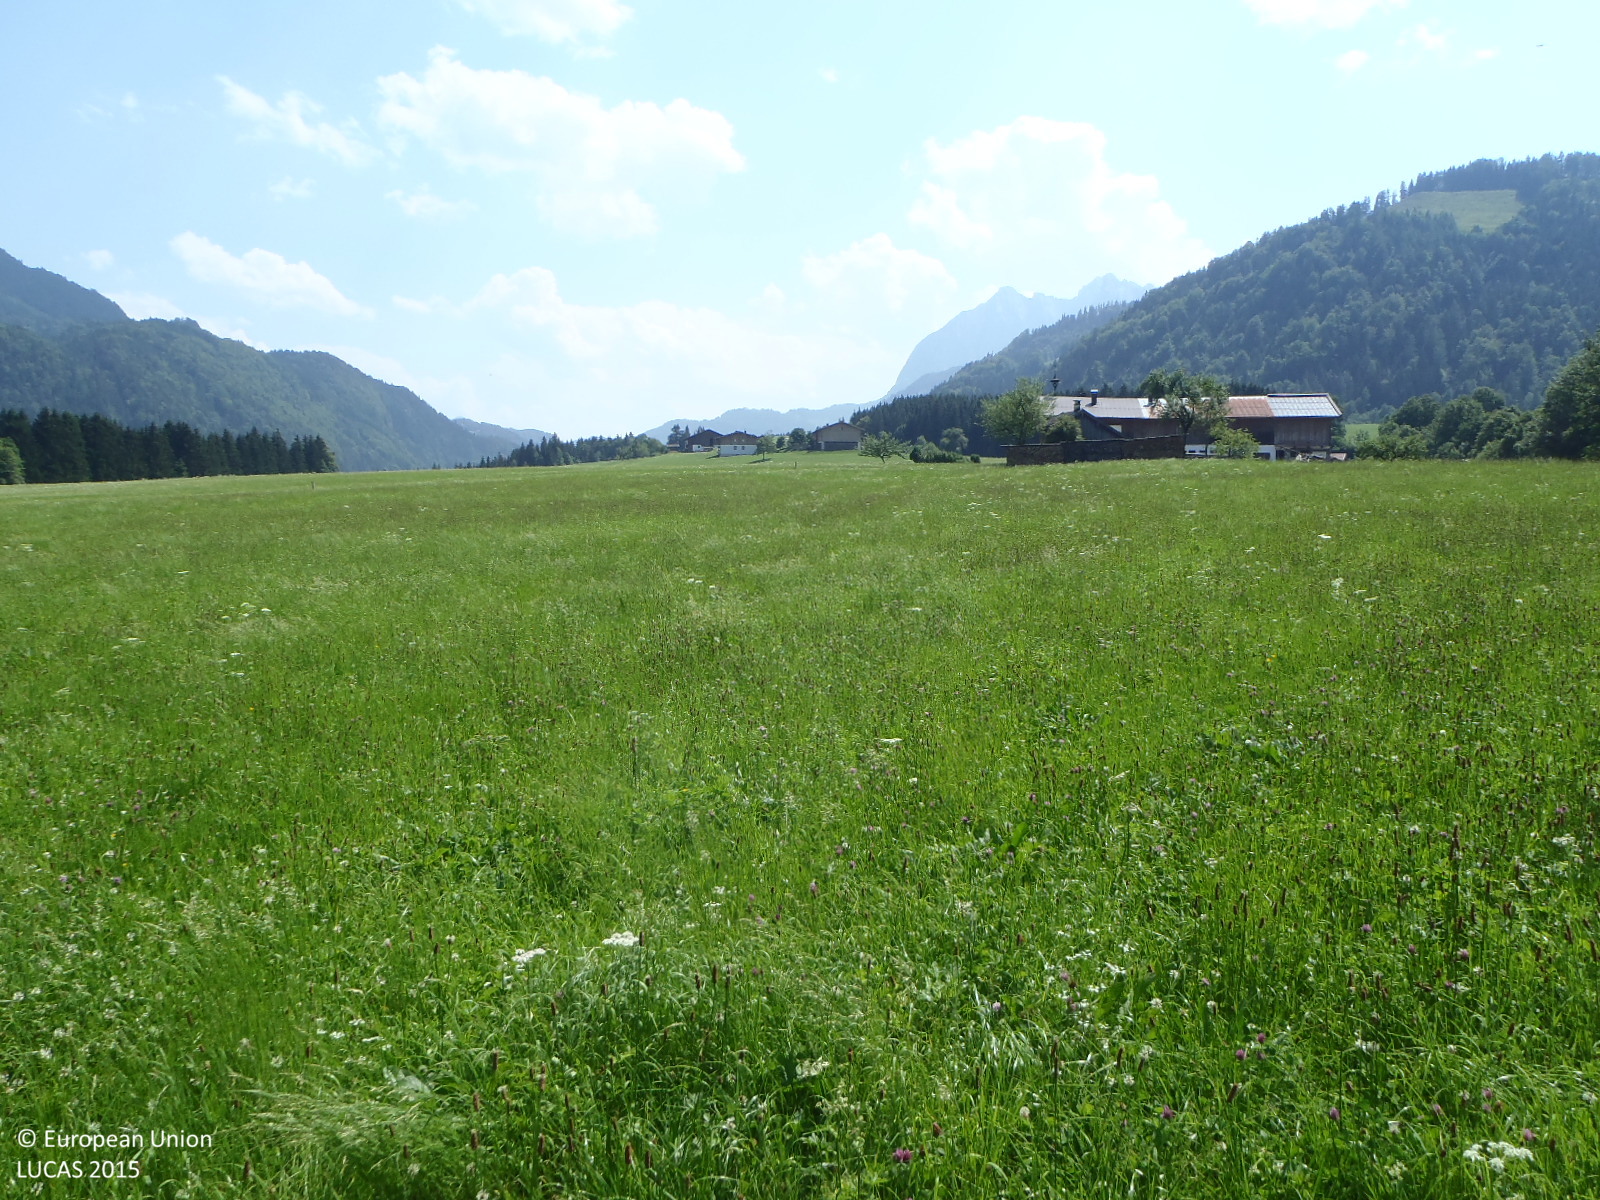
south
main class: Grassland
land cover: Grassland without tree/shrub cover
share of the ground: > 75 %
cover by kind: herbaceous plants 100 %
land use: Agriculture (excluding fallow land and kitchen gardens)
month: July
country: AT
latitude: 47.6397
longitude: 12.3811
